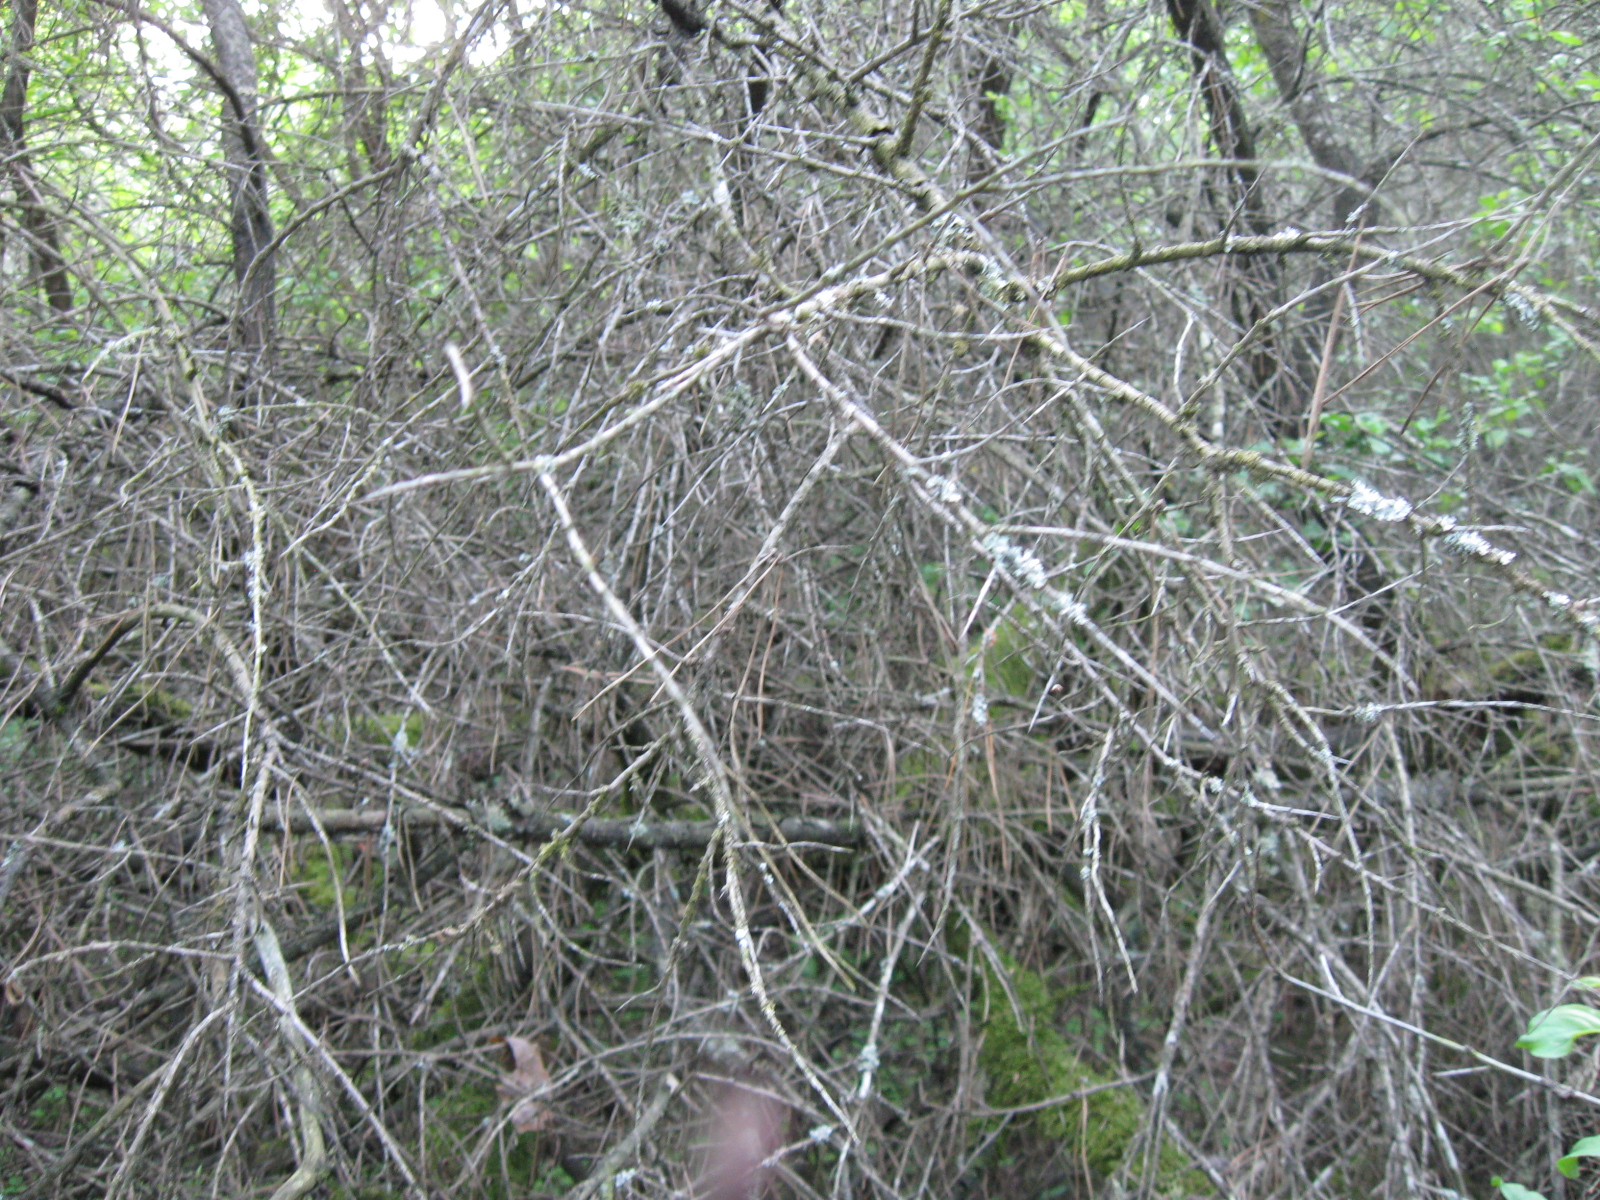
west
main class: Woodland
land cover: Other mixed woodland
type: hemiboreal forest and nemoral coniferous forest and mixed broadleaved-coniferous forest
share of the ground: > 75 %
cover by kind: broadleaved forest trees 70 %, coniferous forest trees 30 %
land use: Forestry
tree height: > 5 m
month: June
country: LT
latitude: 54.1660
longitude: 23.7344
